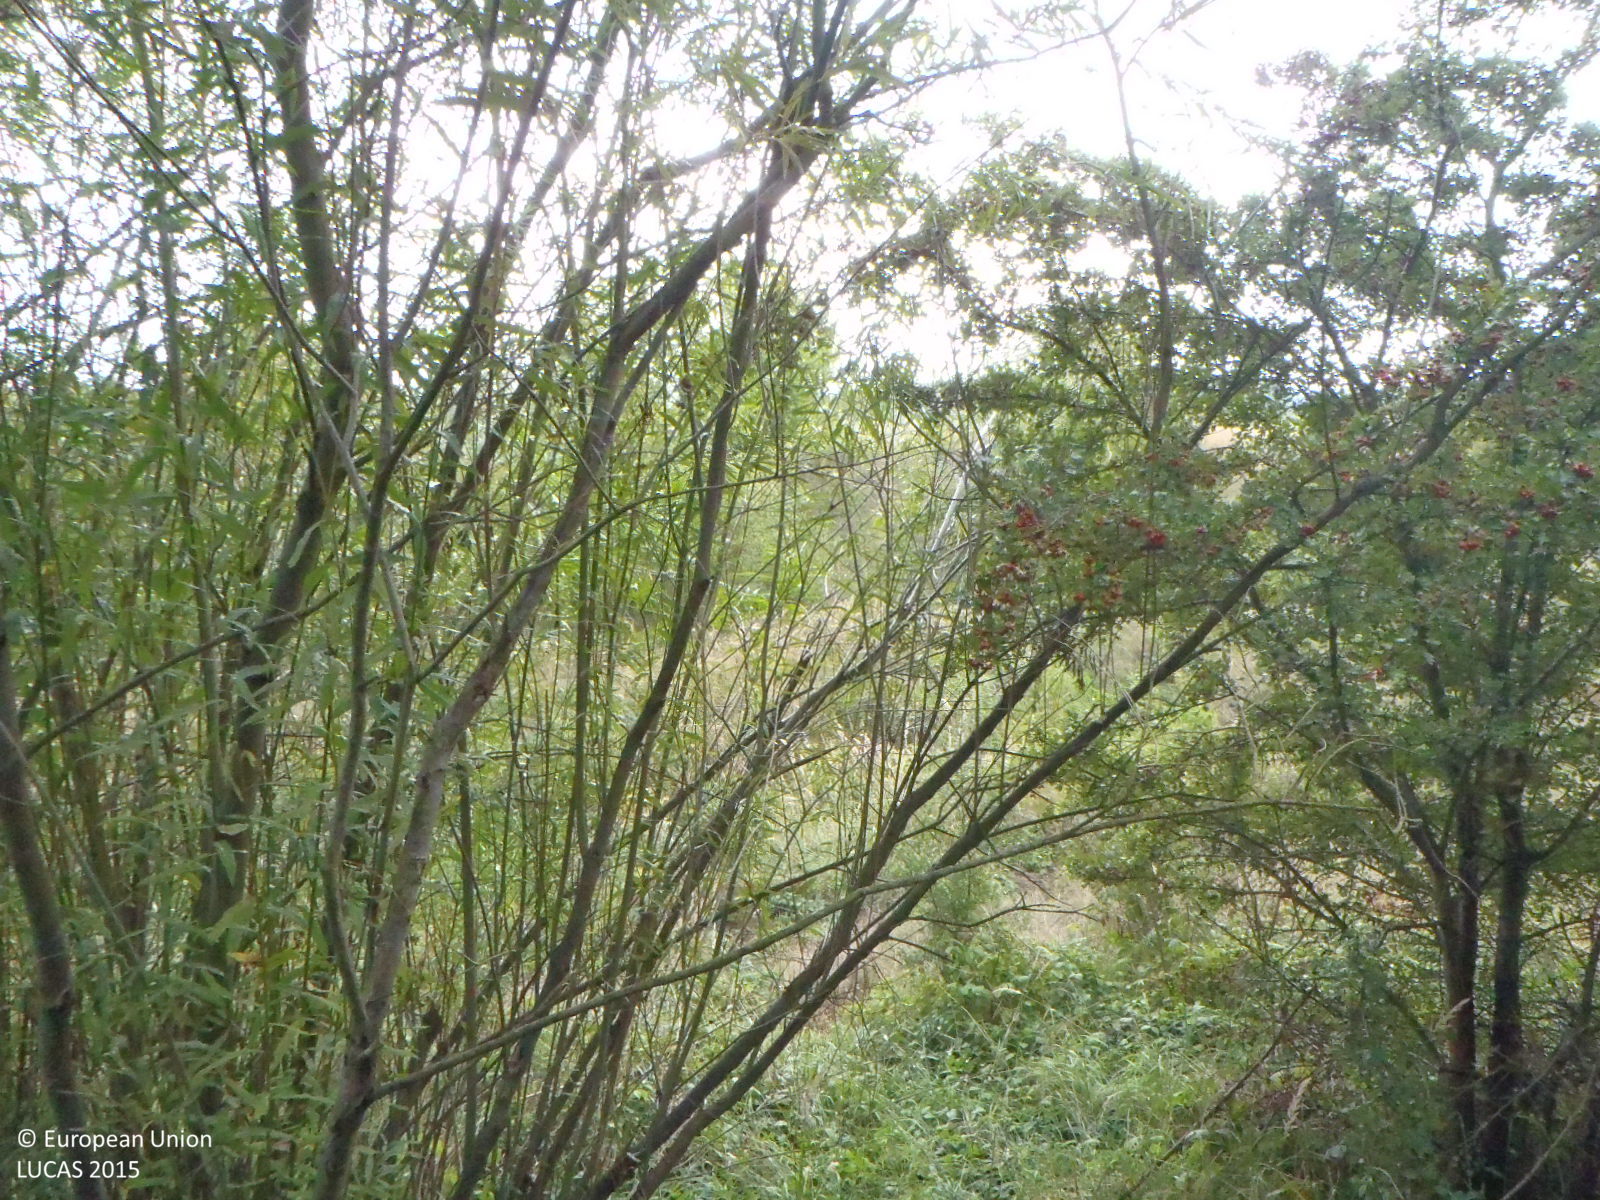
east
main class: Woodland
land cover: Broadleaved woodland
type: floodplain forest
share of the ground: > 75 %
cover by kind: broadleaved forest trees 80 %, shrubs 10 %, herbaceous plants 10 %
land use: Semi-natural and natural areas not in use
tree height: > 5 m
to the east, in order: Broadleaved woodland; Grassland with sparse tree/shrub cover; Rivers and streams; Grassland with sparse tree/shrub cover; Paved roads, cycling and walking lanes; Broadleaved woodland; Lucerne; Grassland with sparse tree/shrub cover; Ditches and canals; Grassland with sparse tree/shrub cover; Lucerne
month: September
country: CZ
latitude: 50.6579
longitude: 13.8909
